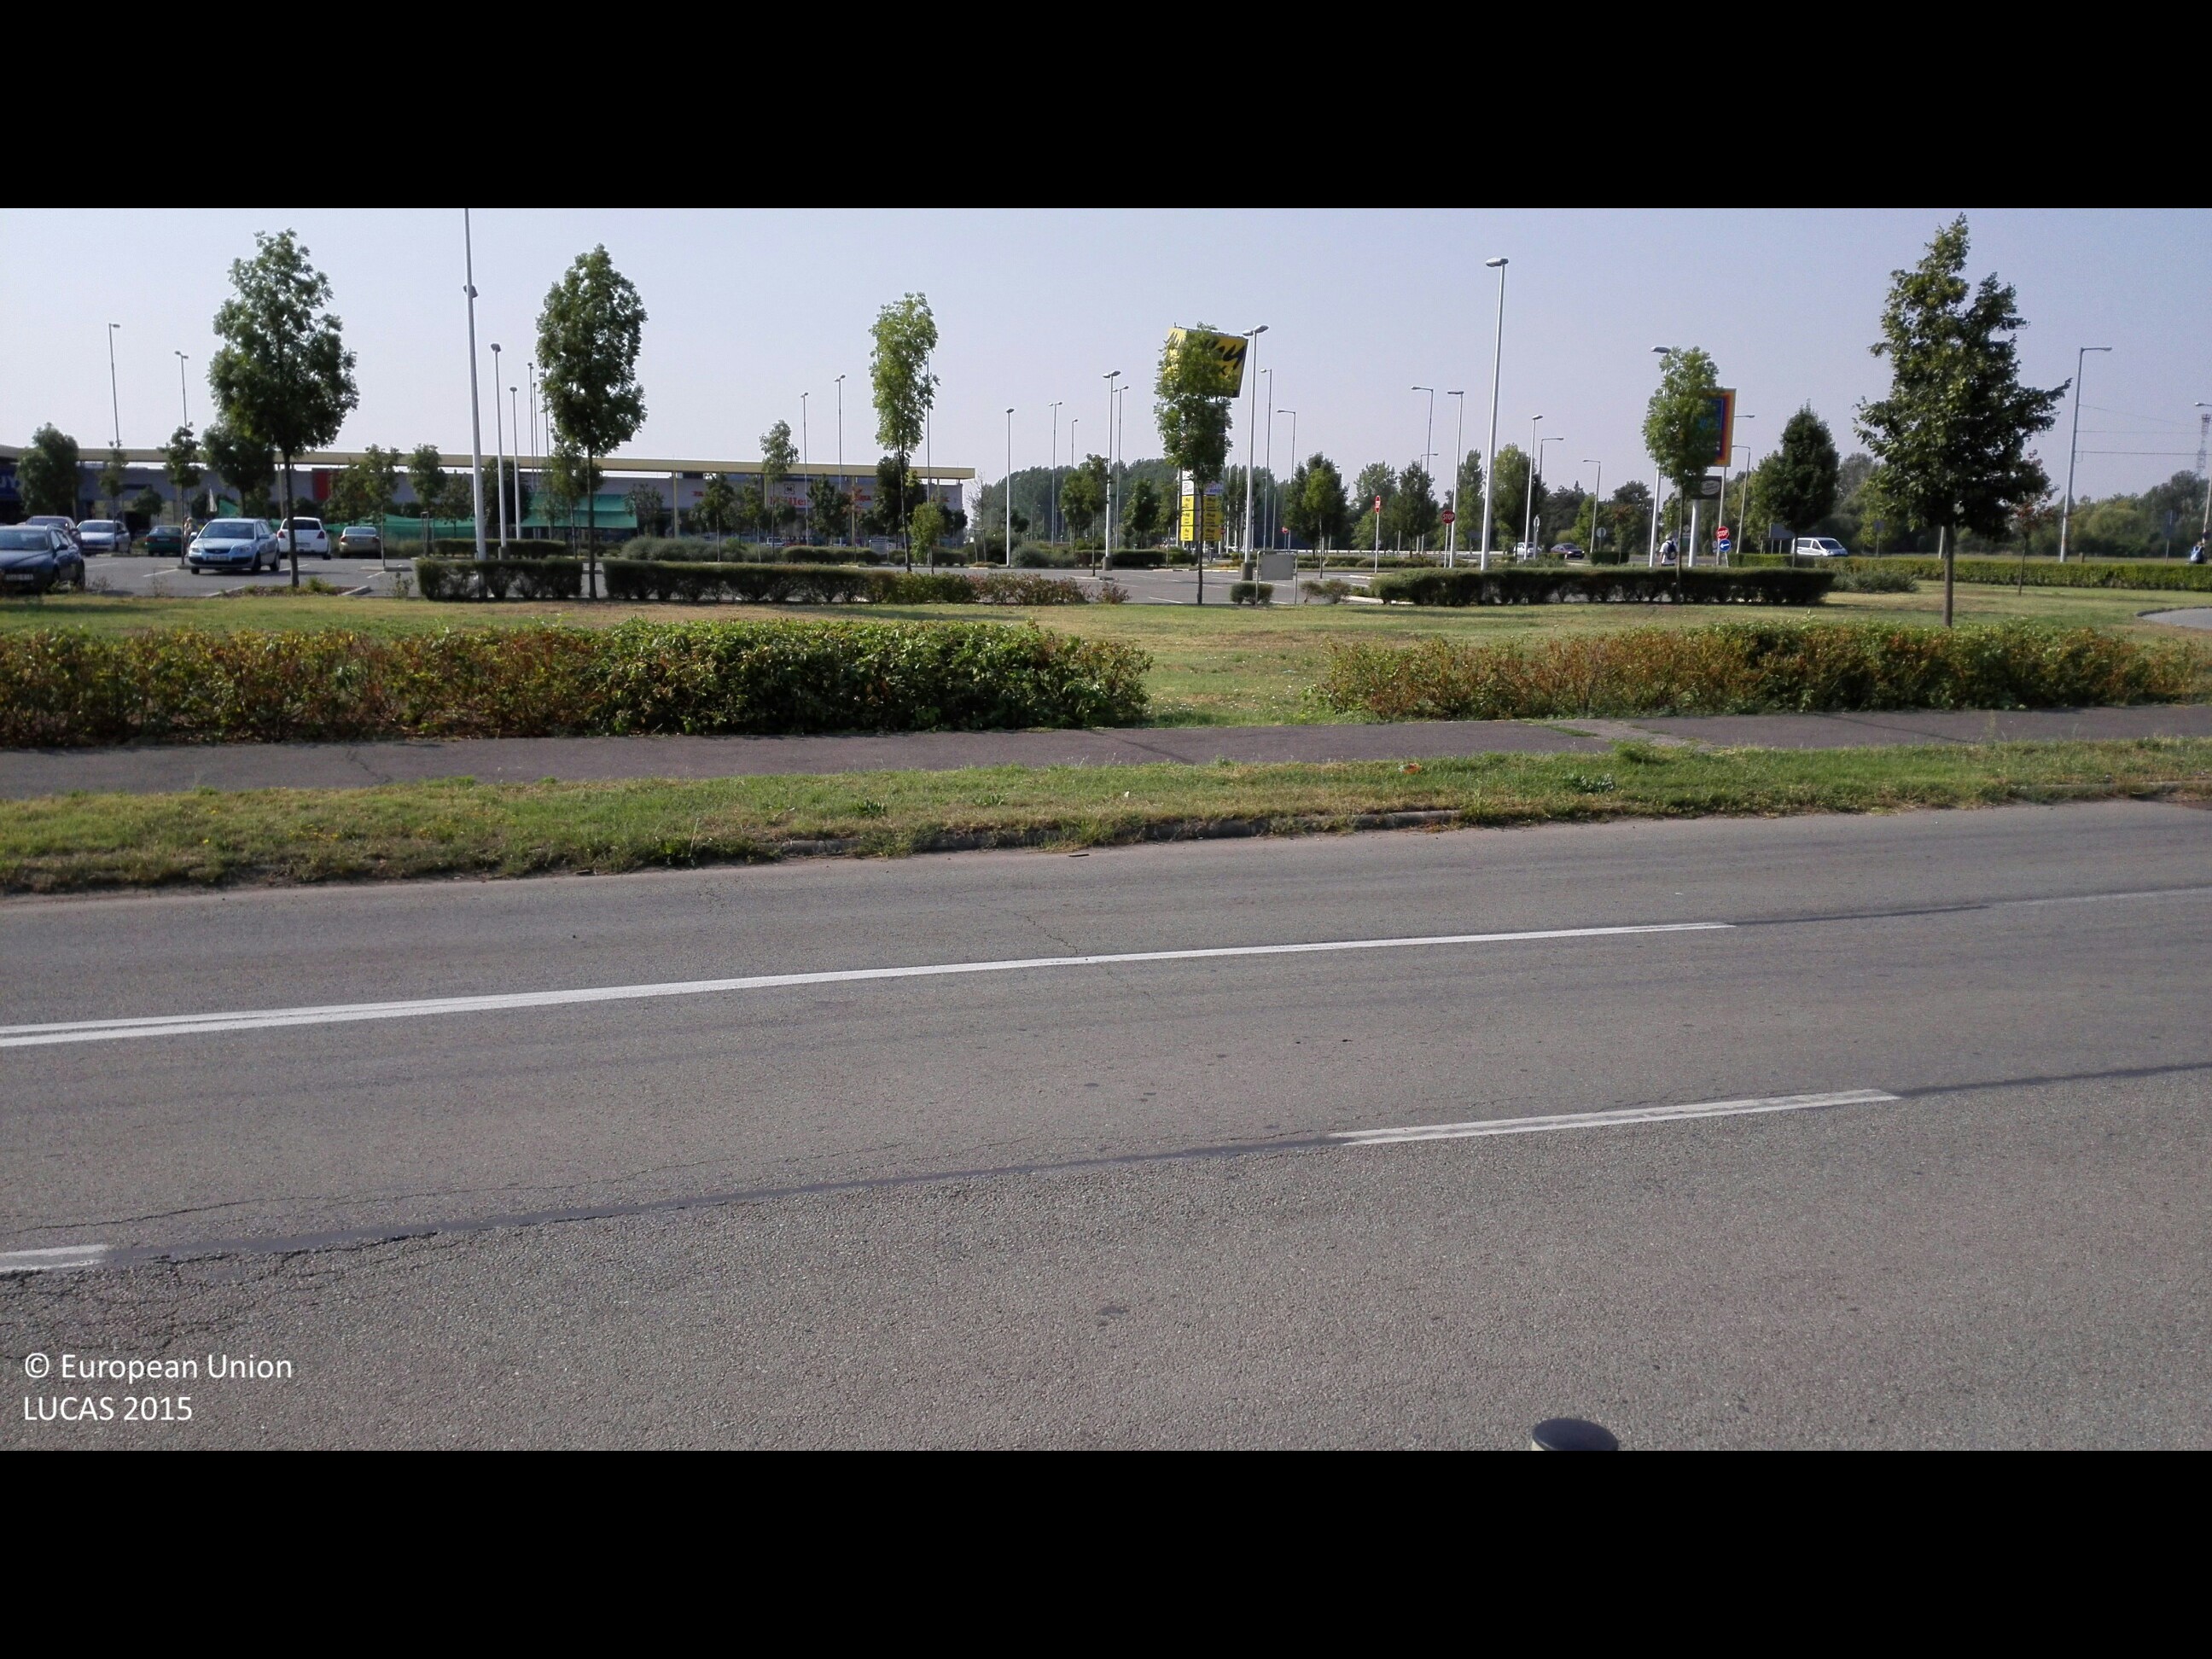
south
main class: Grassland
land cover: Grassland with sparse tree/shrub cover
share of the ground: > 75 %
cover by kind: herbaceous plants 95 %, broadleaved forest trees 5 %
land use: Residential
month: August
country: HU
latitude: 47.4963
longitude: 21.6330
